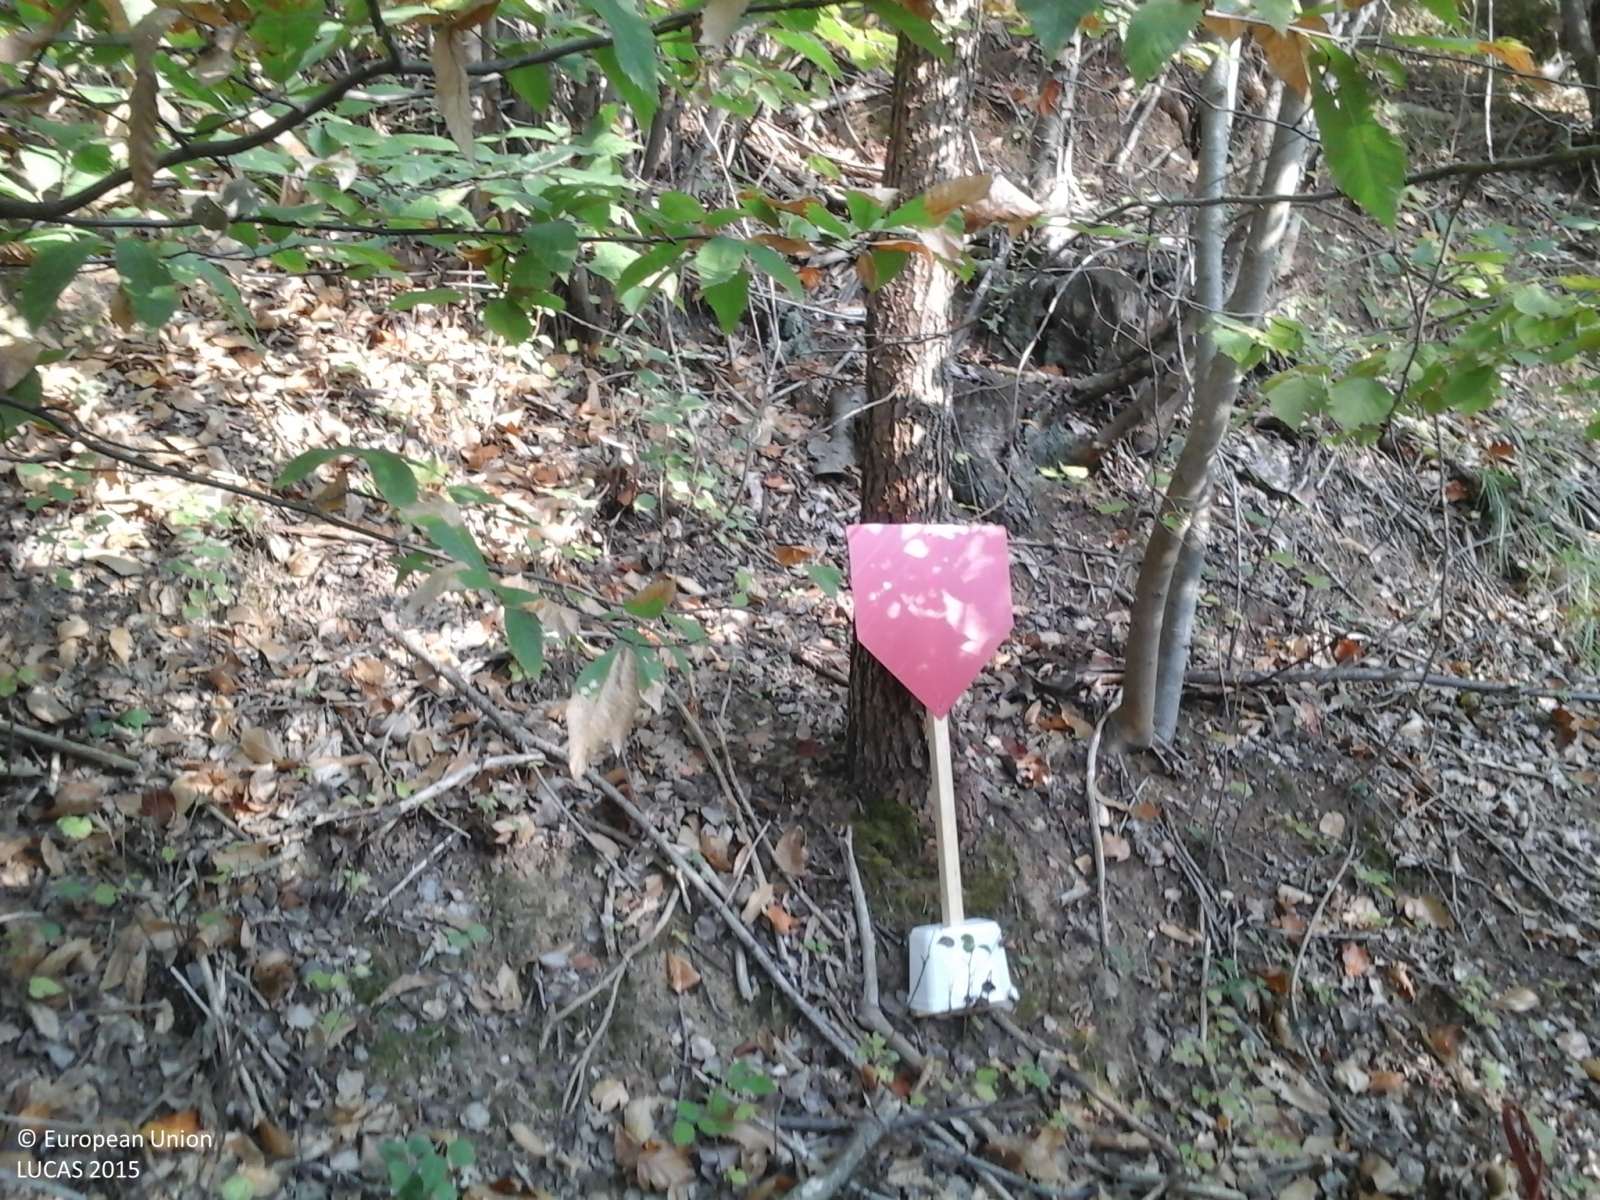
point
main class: Woodland
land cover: Broadleaved woodland
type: thermophilous deciduous forest
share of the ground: > 75 %
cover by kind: broadleaved forest trees 90 %, herbaceous plants 10 %
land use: Forestry
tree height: > 5 m
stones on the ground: 10 - 25 %
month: September
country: IT
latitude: 44.3360
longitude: 8.2606
